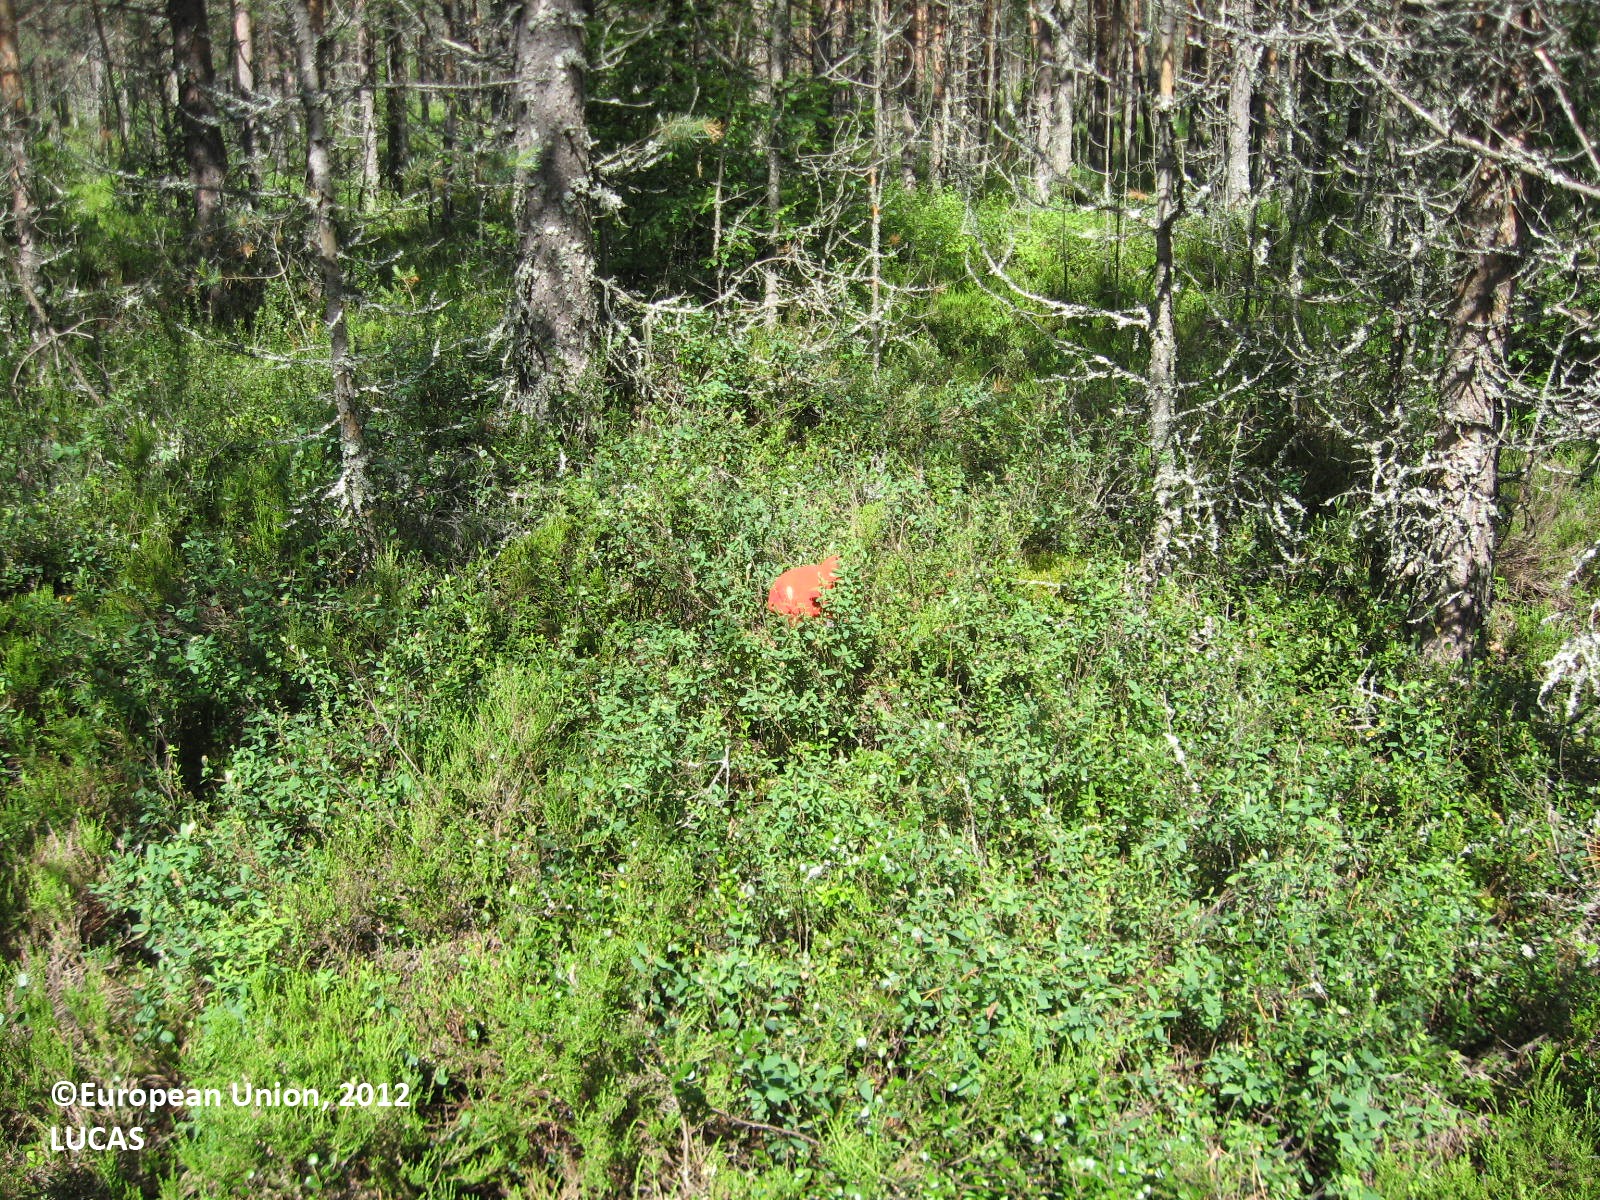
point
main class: Woodland
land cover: Pine dominated coniferous woodland
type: boreal forest
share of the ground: > 75 %
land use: Forestry
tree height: > 5 m
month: July
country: FI
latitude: 62.3391
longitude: 22.3546
